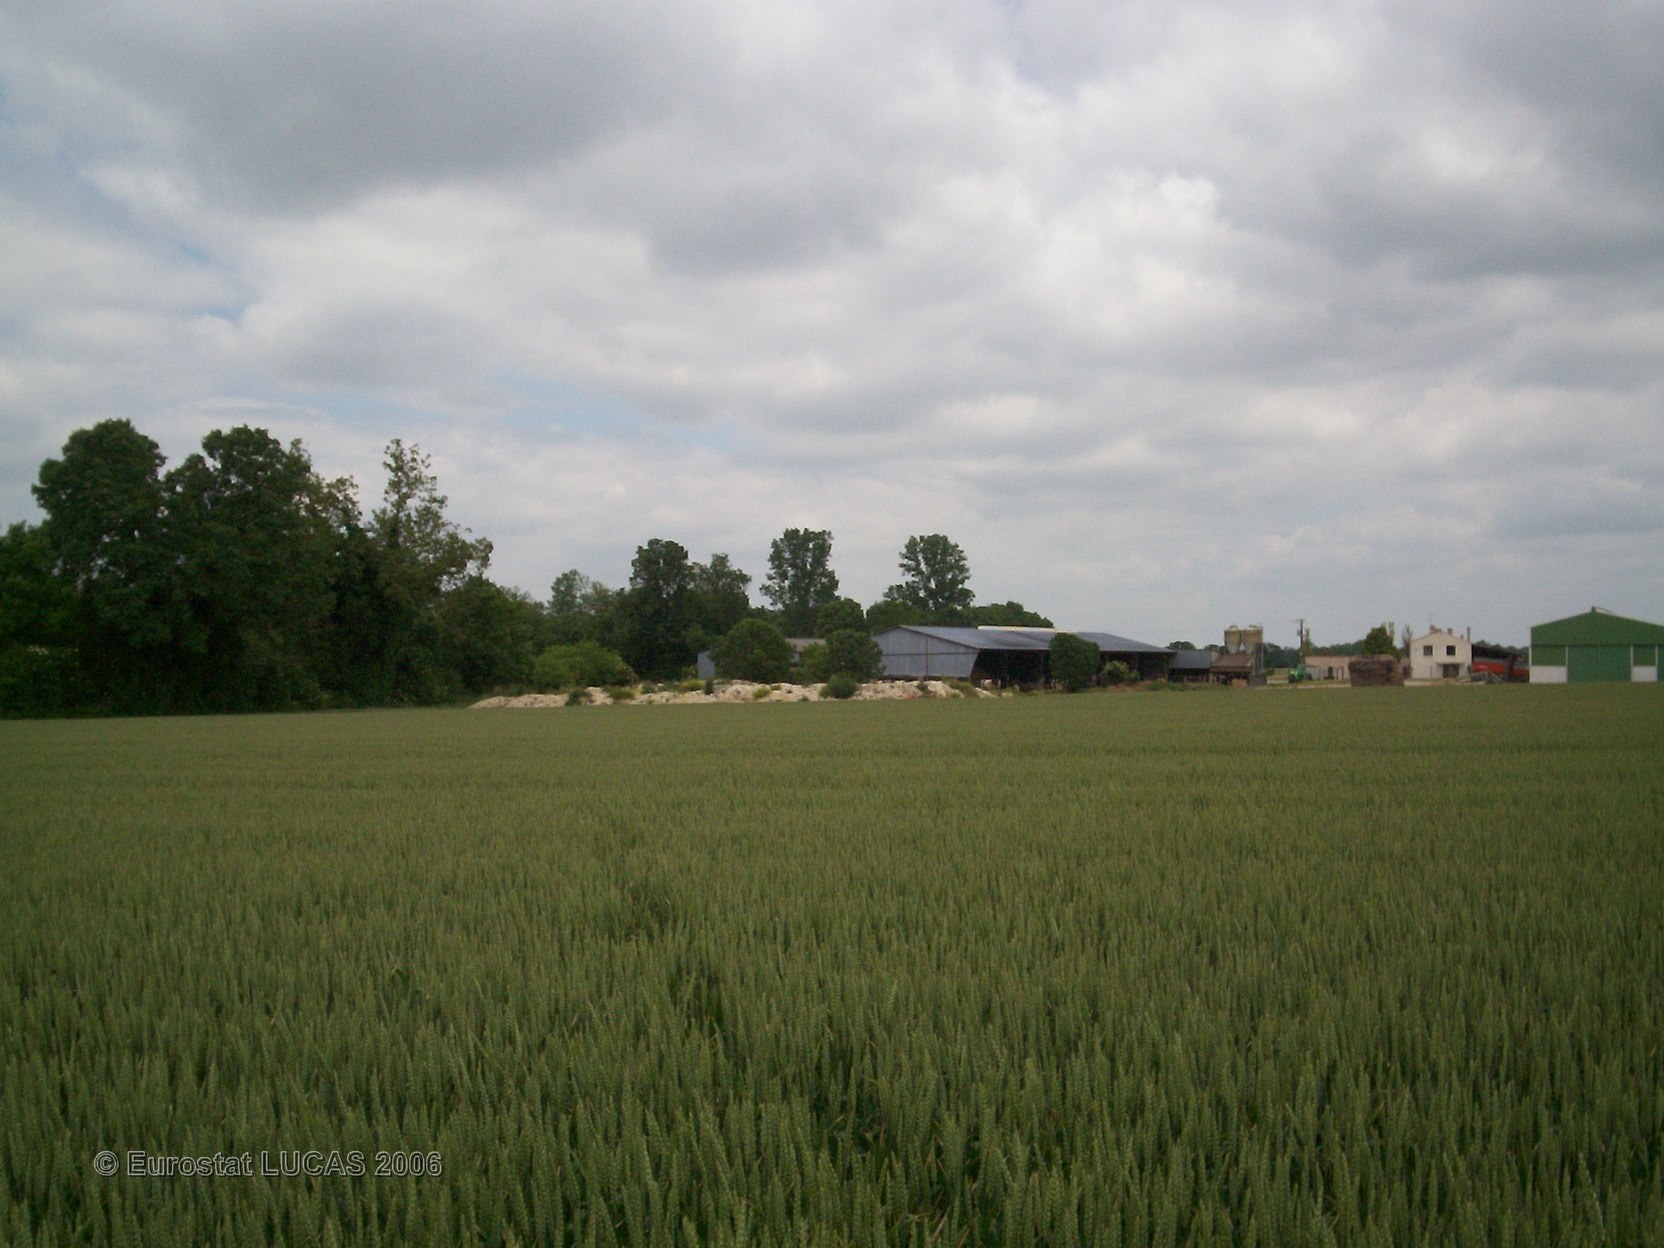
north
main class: Cropland
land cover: Common wheat
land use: Agriculture (excluding fallow land and kitchen gardens)
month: June
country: FR
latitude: 46.1183
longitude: -0.9115
